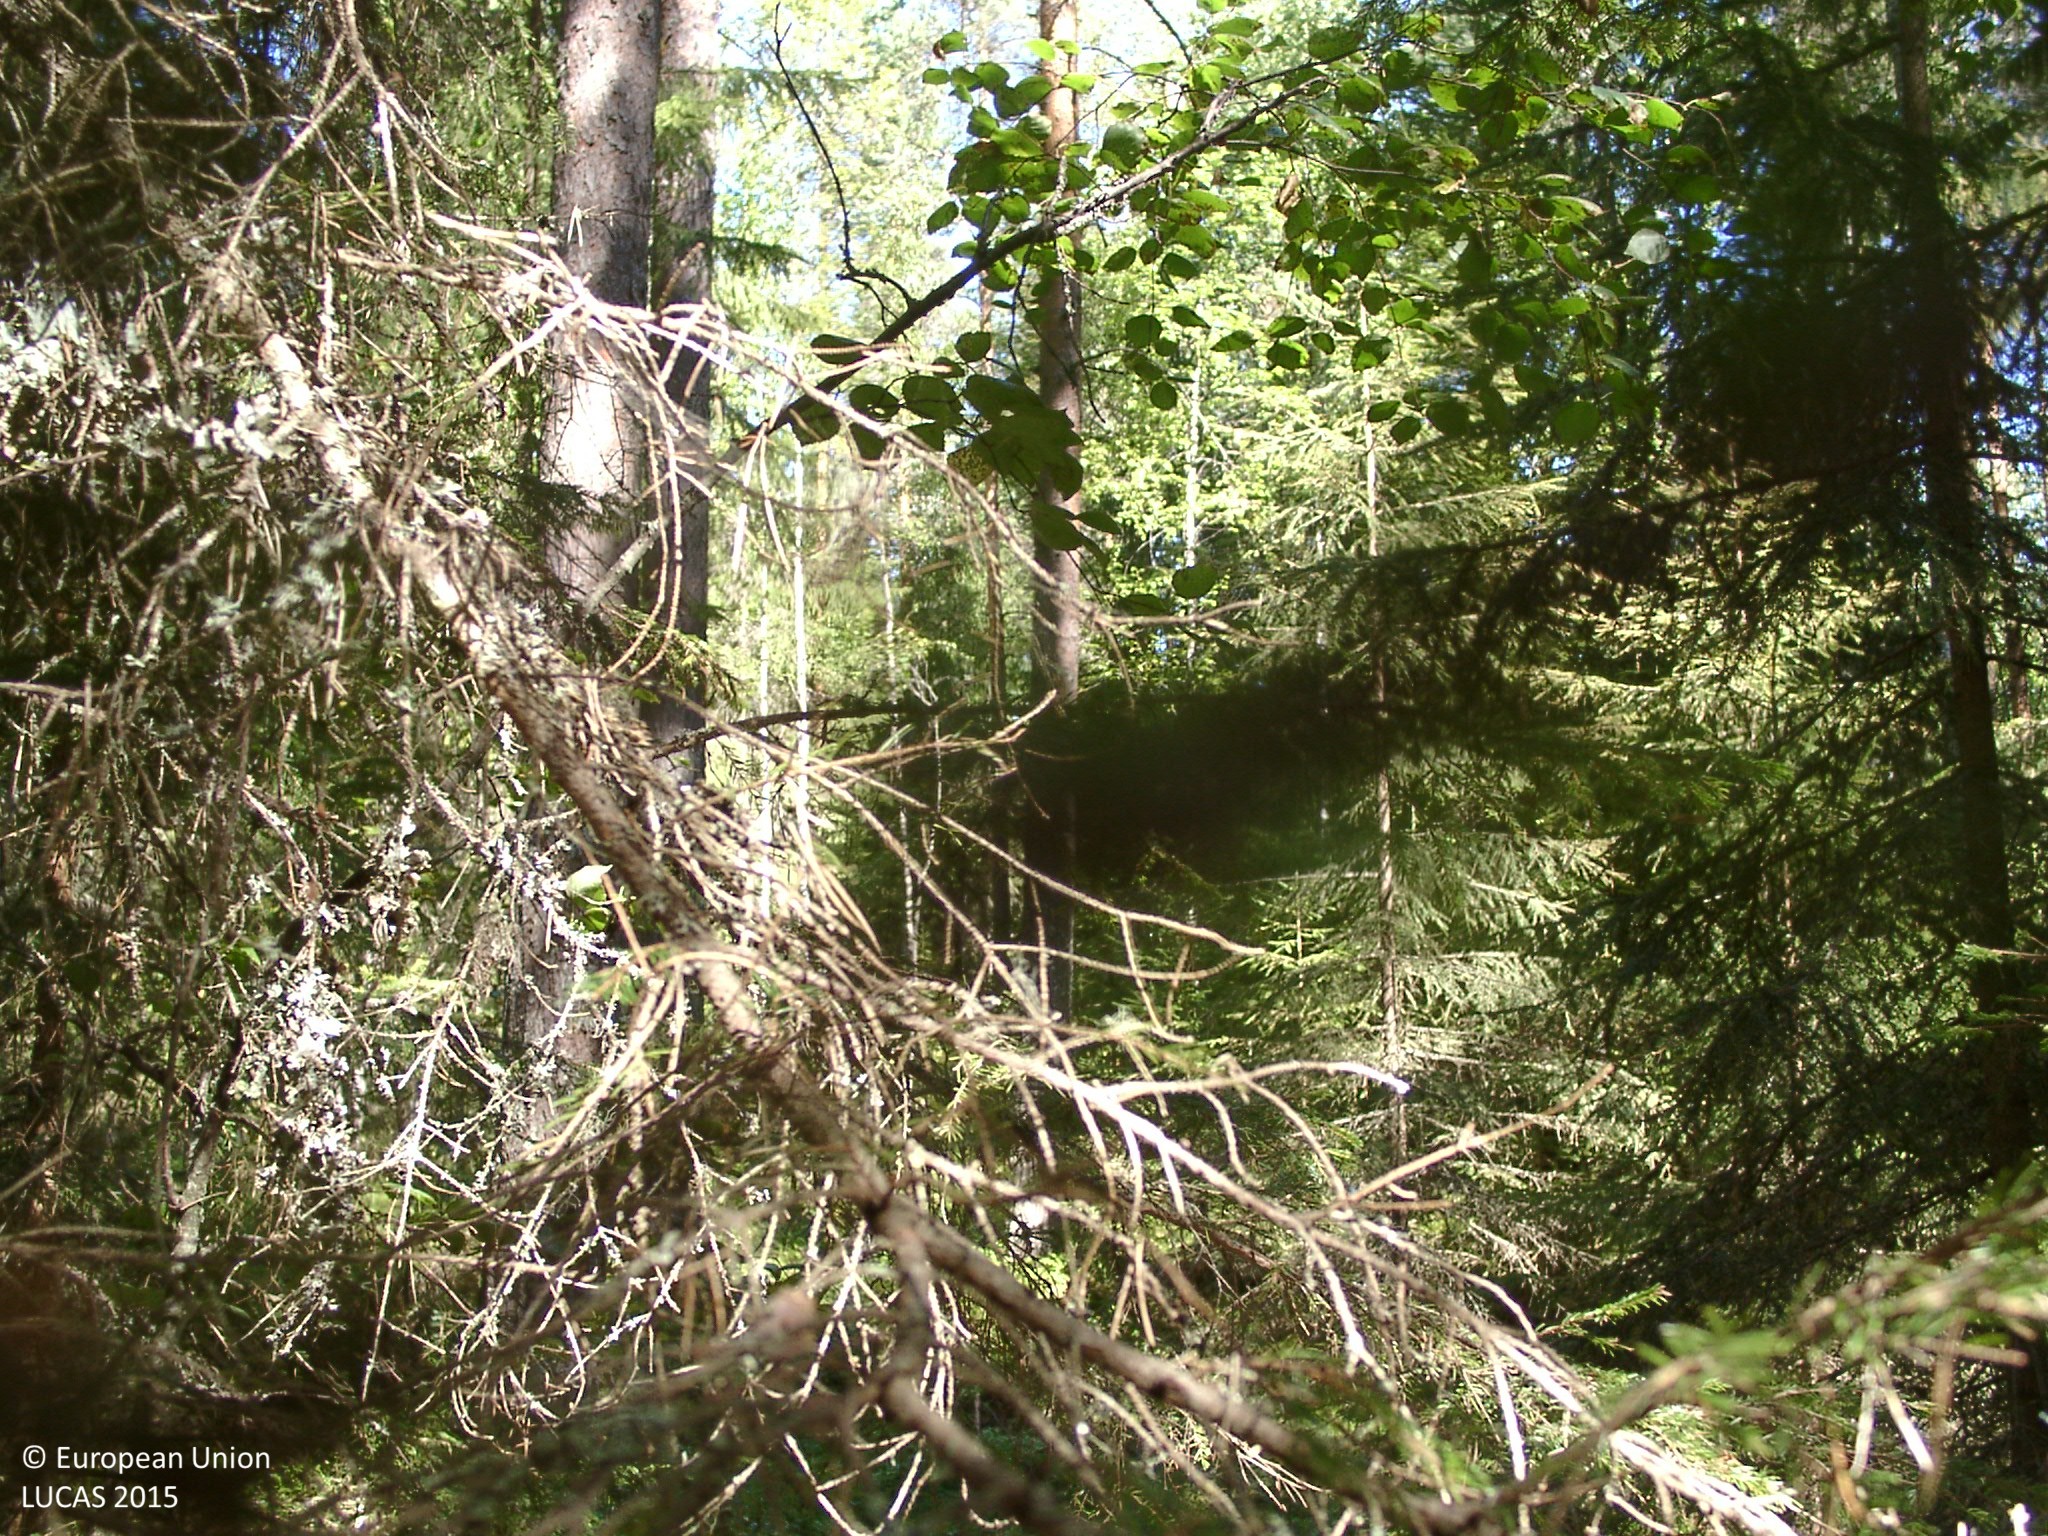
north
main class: Woodland
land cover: Other coniferous woodland
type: boreal forest
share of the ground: > 75 %
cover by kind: coniferous forest trees 65 %, broadleaved forest trees 20 %, shrubs 10 %, lichens and mosses 5 %
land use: Forestry
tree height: > 5 m
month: August
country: FI
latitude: 61.9300
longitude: 24.9834
